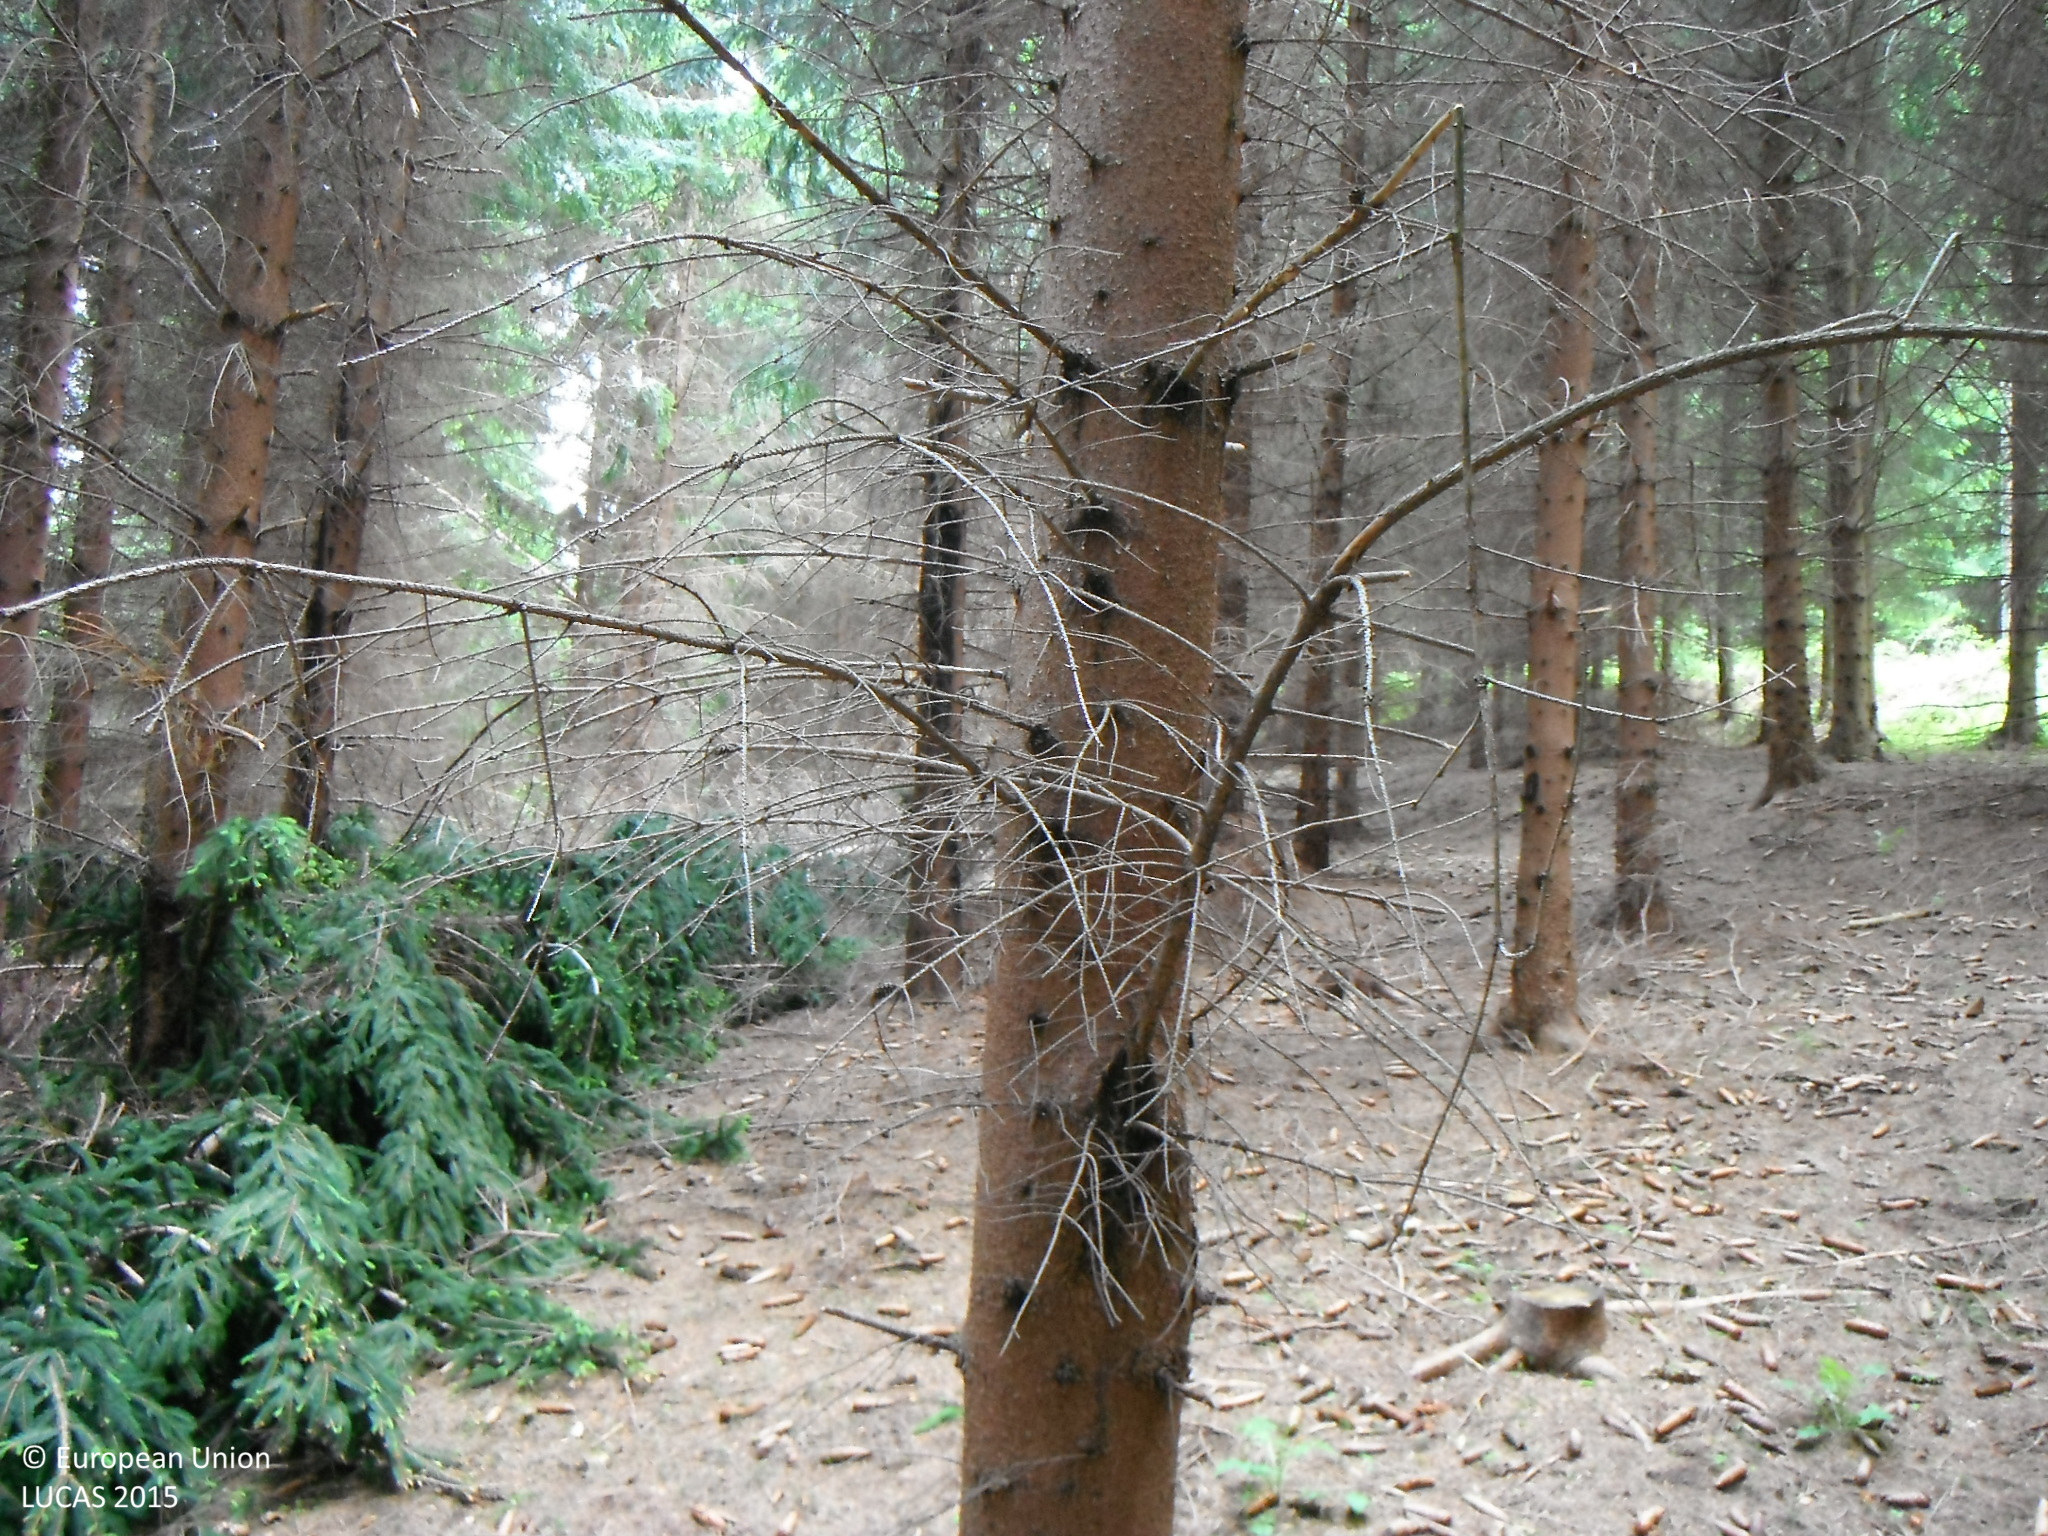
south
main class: Woodland
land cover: Spruce dominated coniferous woodland
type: alpine coniferous forest
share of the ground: > 75 %
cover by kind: coniferous forest trees 100 %
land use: Forestry
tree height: > 5 m
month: June
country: SK
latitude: 48.4377
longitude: 19.3911
